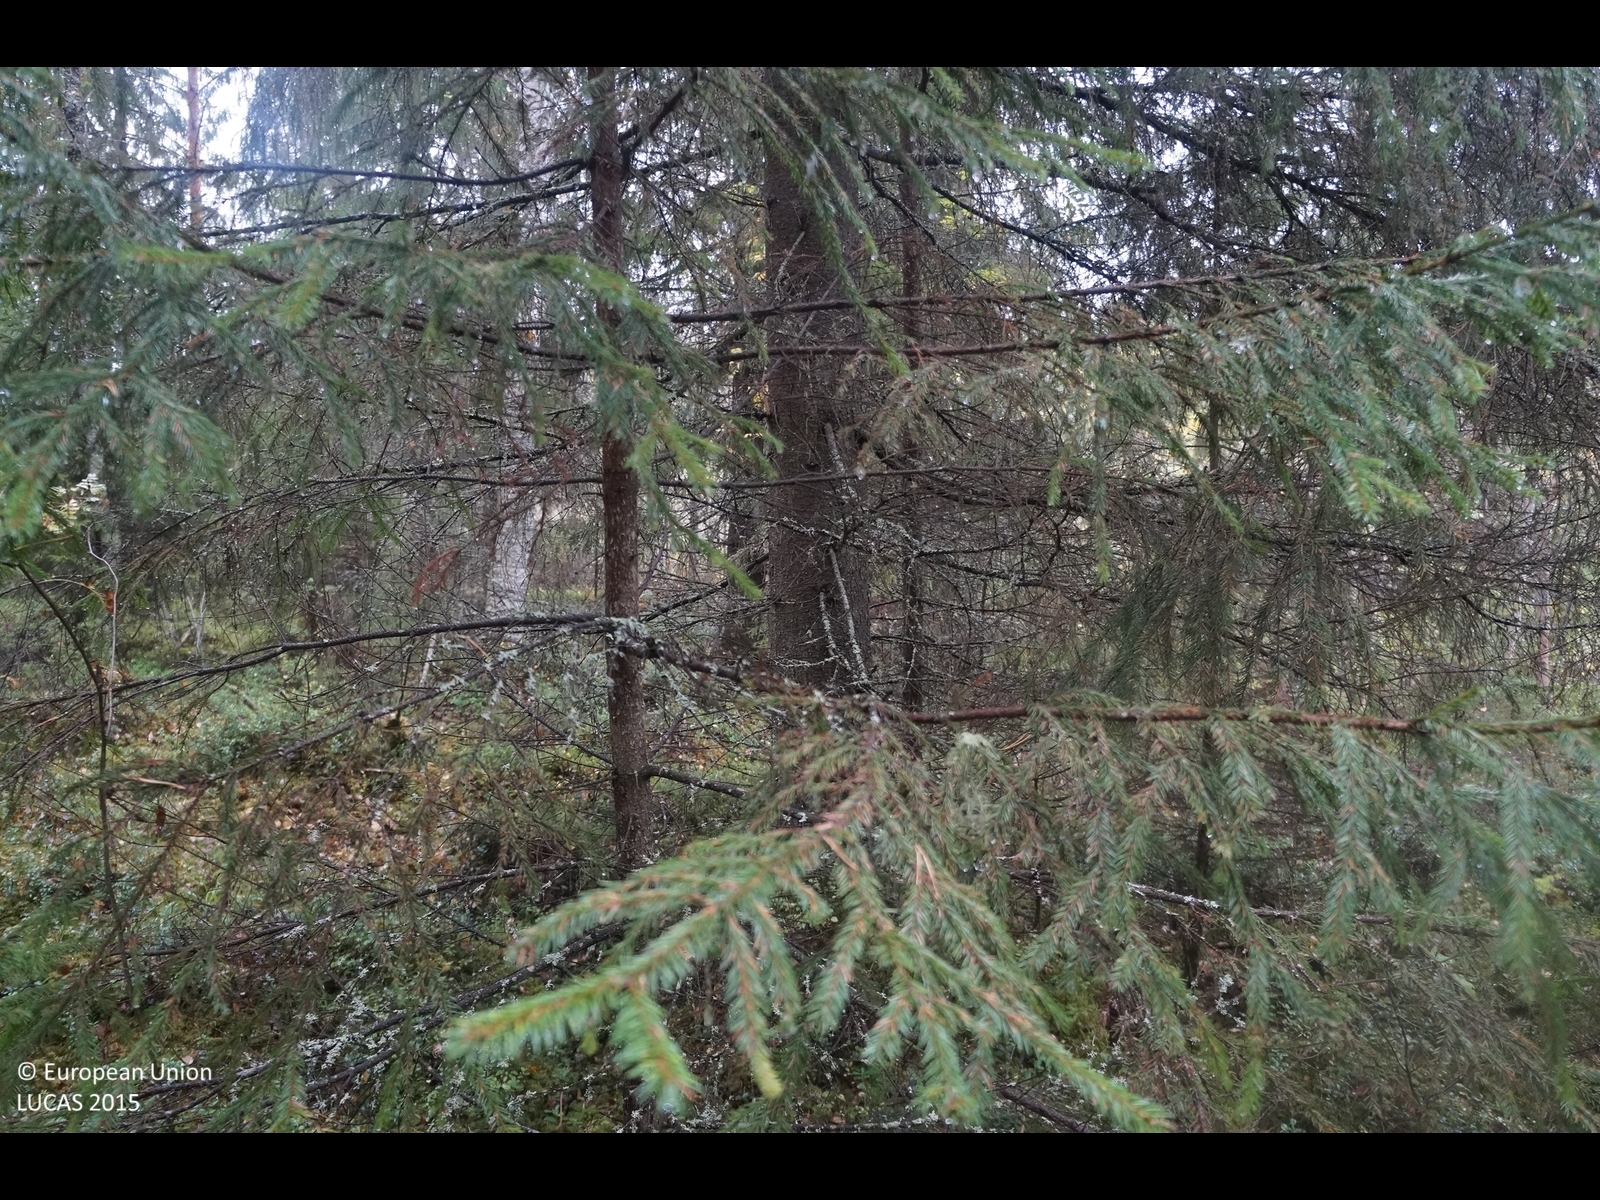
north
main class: Woodland
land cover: Spruce dominated coniferous woodland
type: boreal forest
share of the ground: 50 - 75 %
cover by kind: coniferous forest trees 60 %, shrubs 15 %, lichens and mosses 15 %, herbaceous plants 10 %
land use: Forestry
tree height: > 5 m
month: September
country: FI
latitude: 64.0574
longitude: 24.5183
